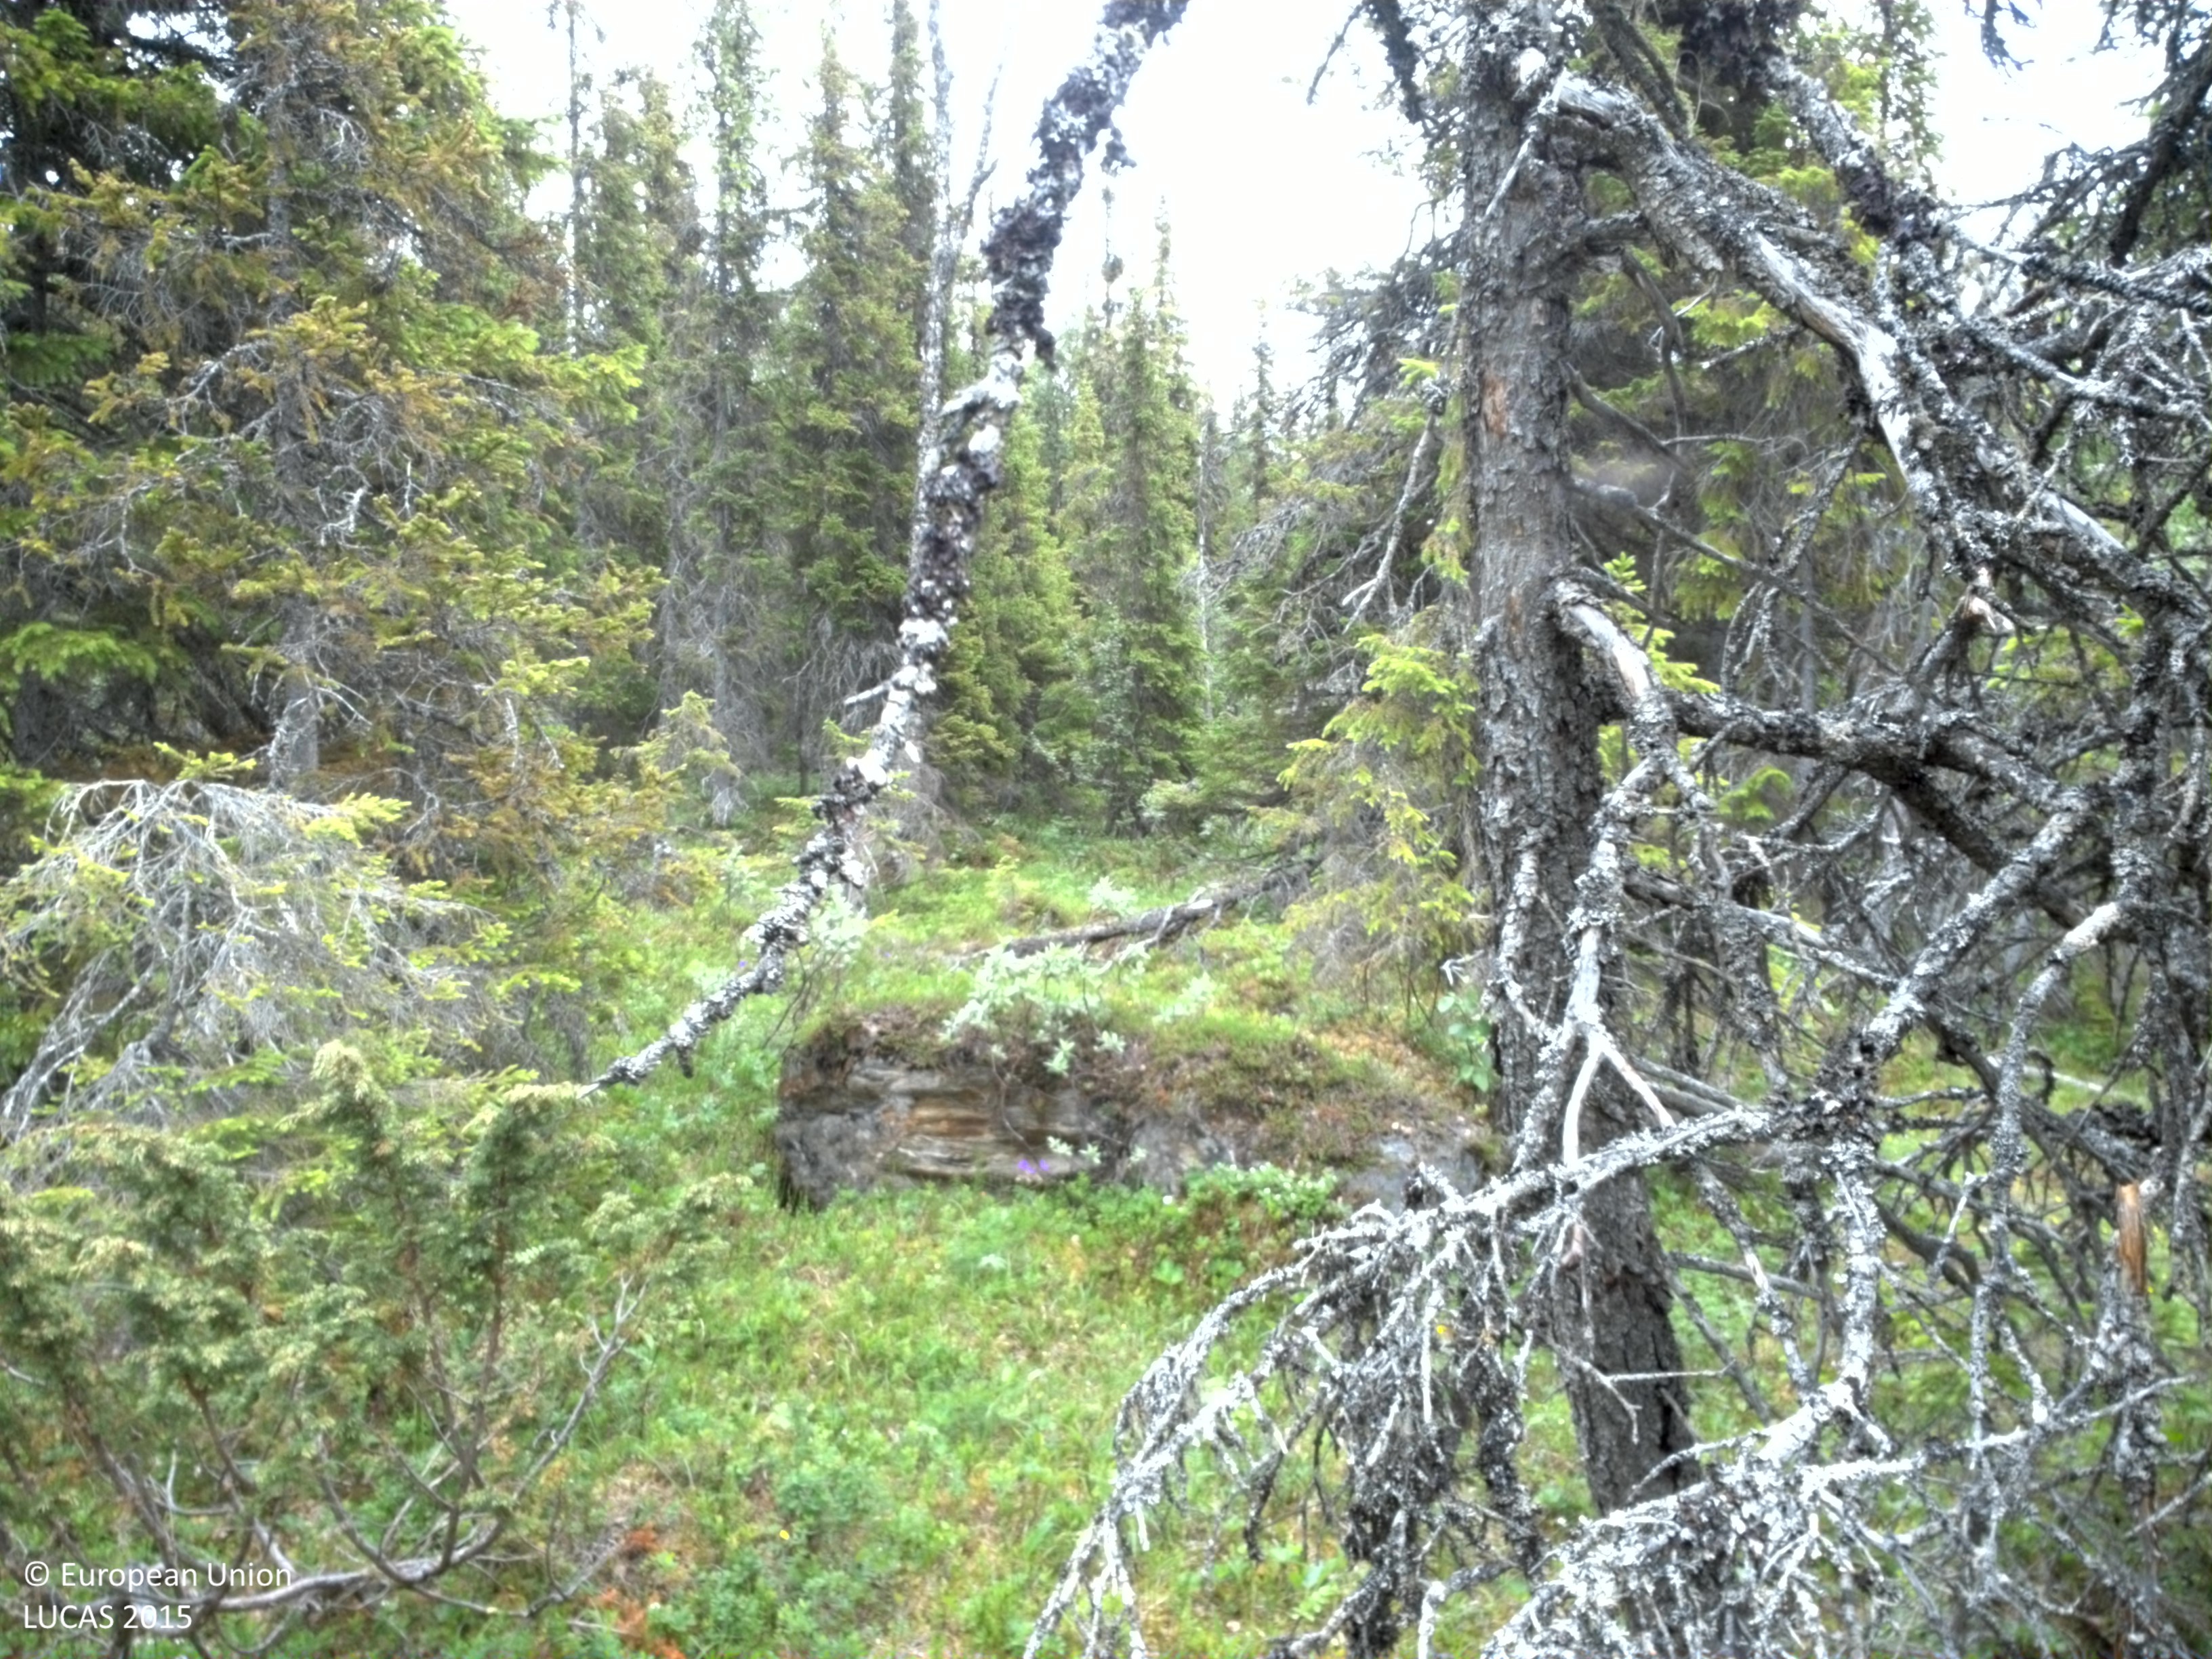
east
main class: Woodland
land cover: Spruce dominated mixed woodland
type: boreal forest
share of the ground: 25 - 50 %
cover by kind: herbaceous plants 35 %, shrubs 30 %, coniferous forest trees 15 %, broadleaved forest trees 10 %, lichens and mosses 10 %
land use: Semi-natural and natural areas not in use
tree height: > 5 m
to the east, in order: Spruce dominated mixed woodland; Spruce dominated coniferous woodland; Rivers and streams; Spruce dominated coniferous woodland; Spruce dominated mixed woodland; Spruce dominated coniferous woodland
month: July
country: SE
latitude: 65.6748
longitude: 15.6416
